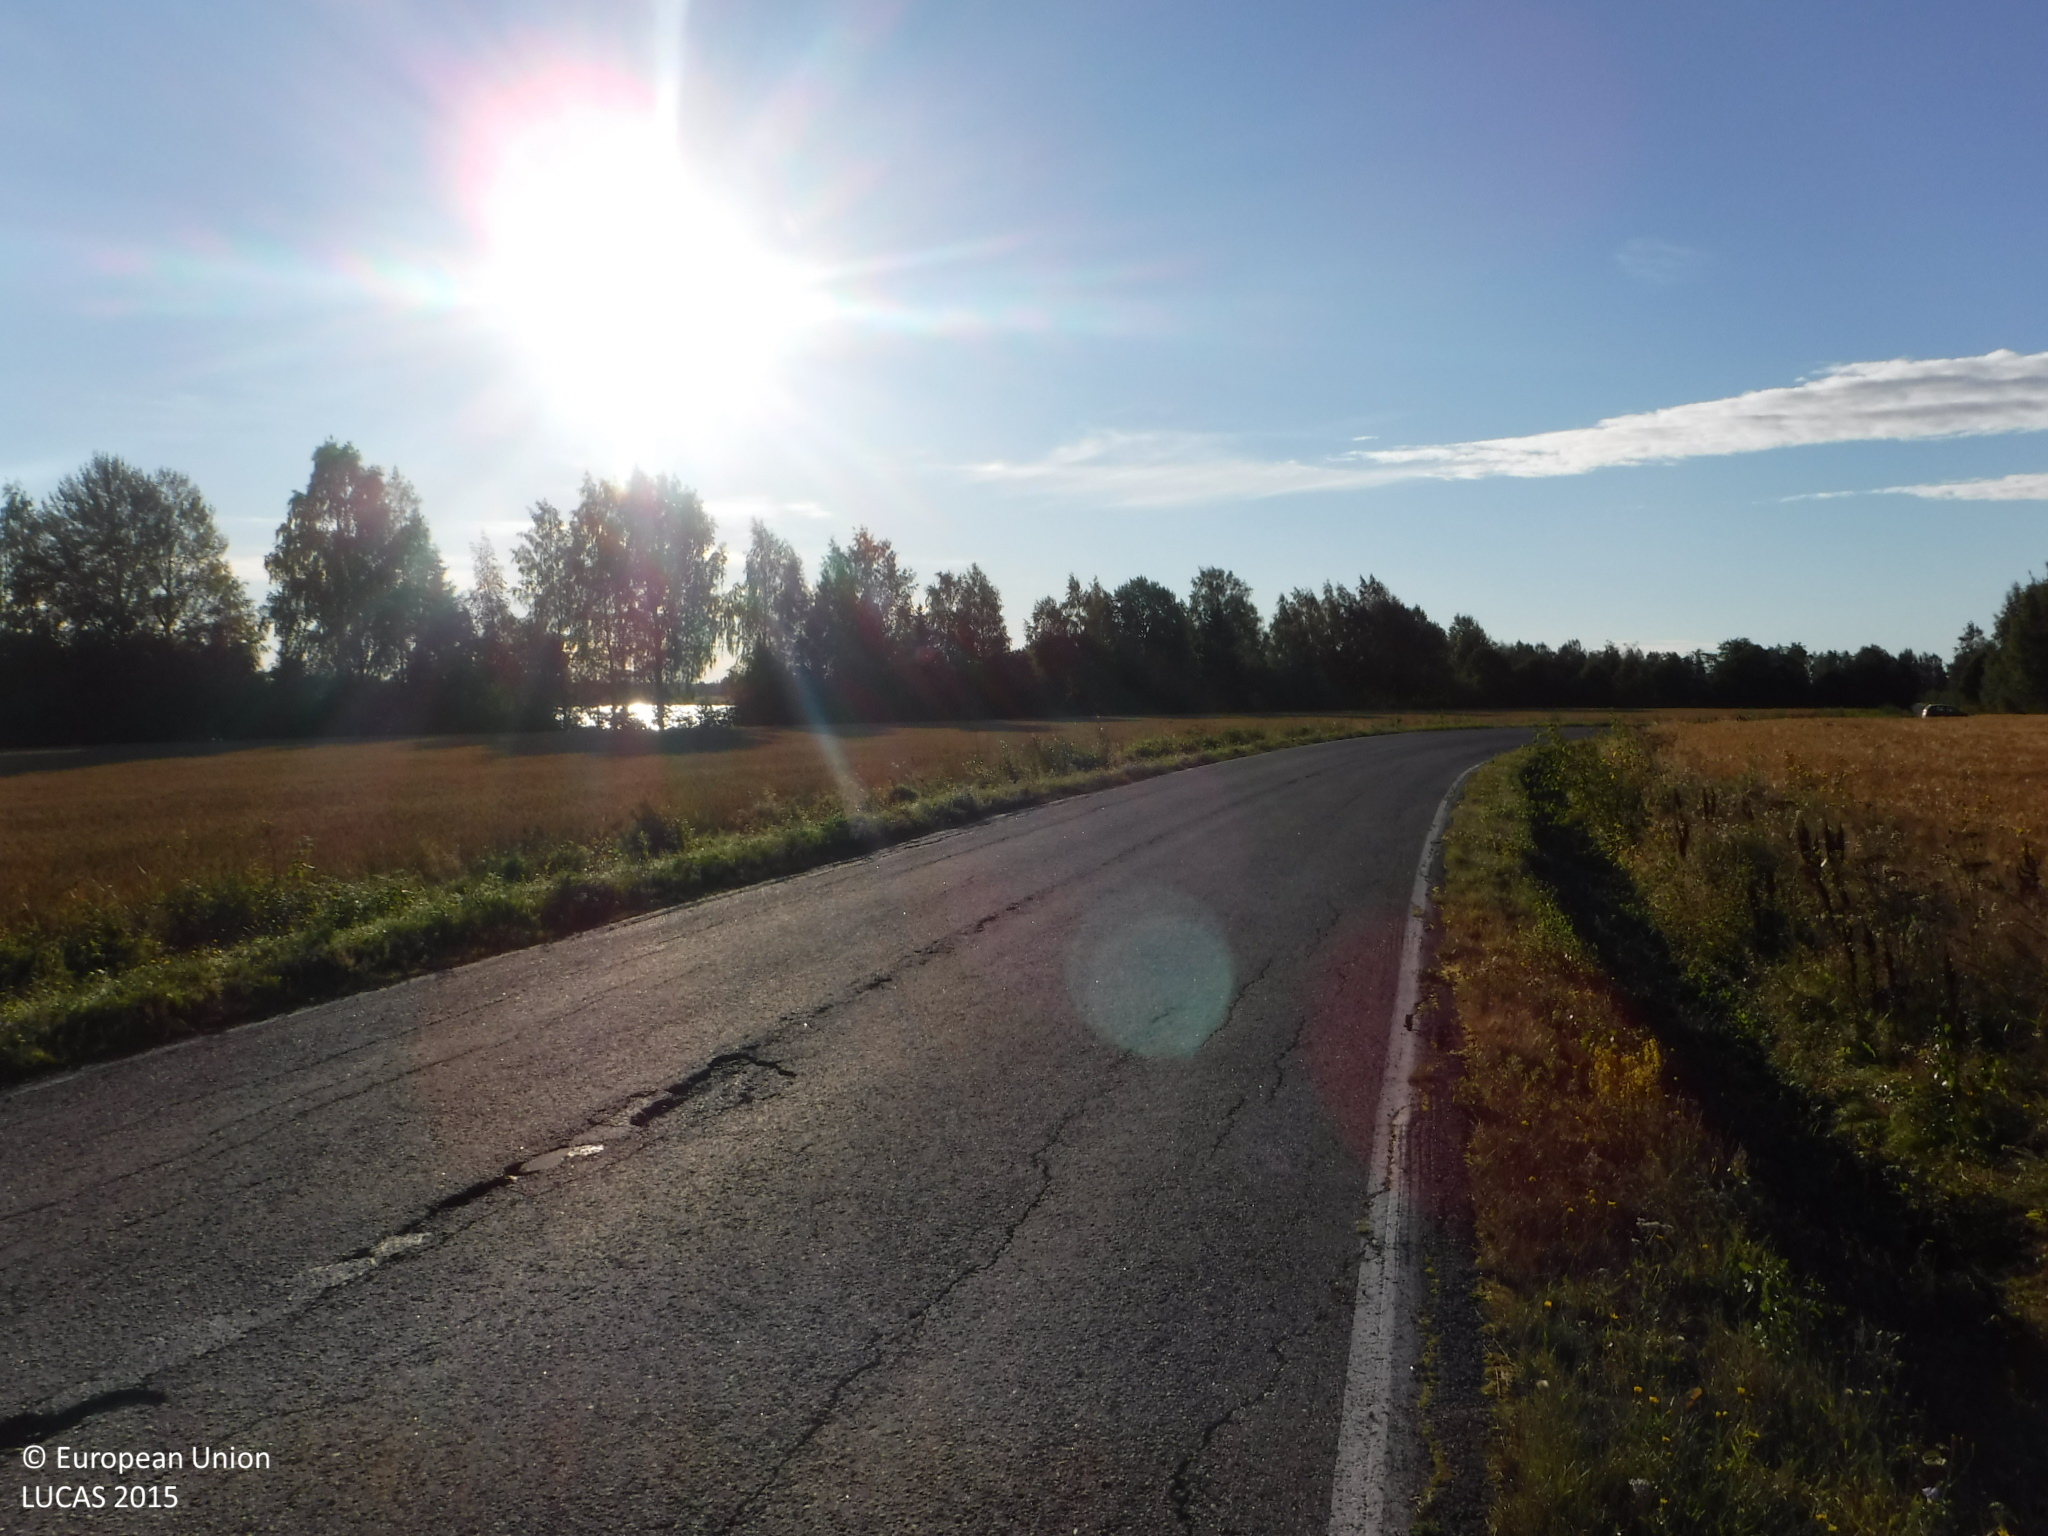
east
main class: Cropland
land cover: Barley
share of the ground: > 75 %
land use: Agriculture (excluding fallow land and kitchen gardens)
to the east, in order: Barley; Grass margins; Ditches and canals; Grass margins; Paved roads, cycling and walking lanes; Grass margins; Ditches and canals; Grass margins; Common wheat; Spontaneously vegetated surfaces; Broadleaved woodland; Inland fresh running water
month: August
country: FI
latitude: 61.2910
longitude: 22.2096
